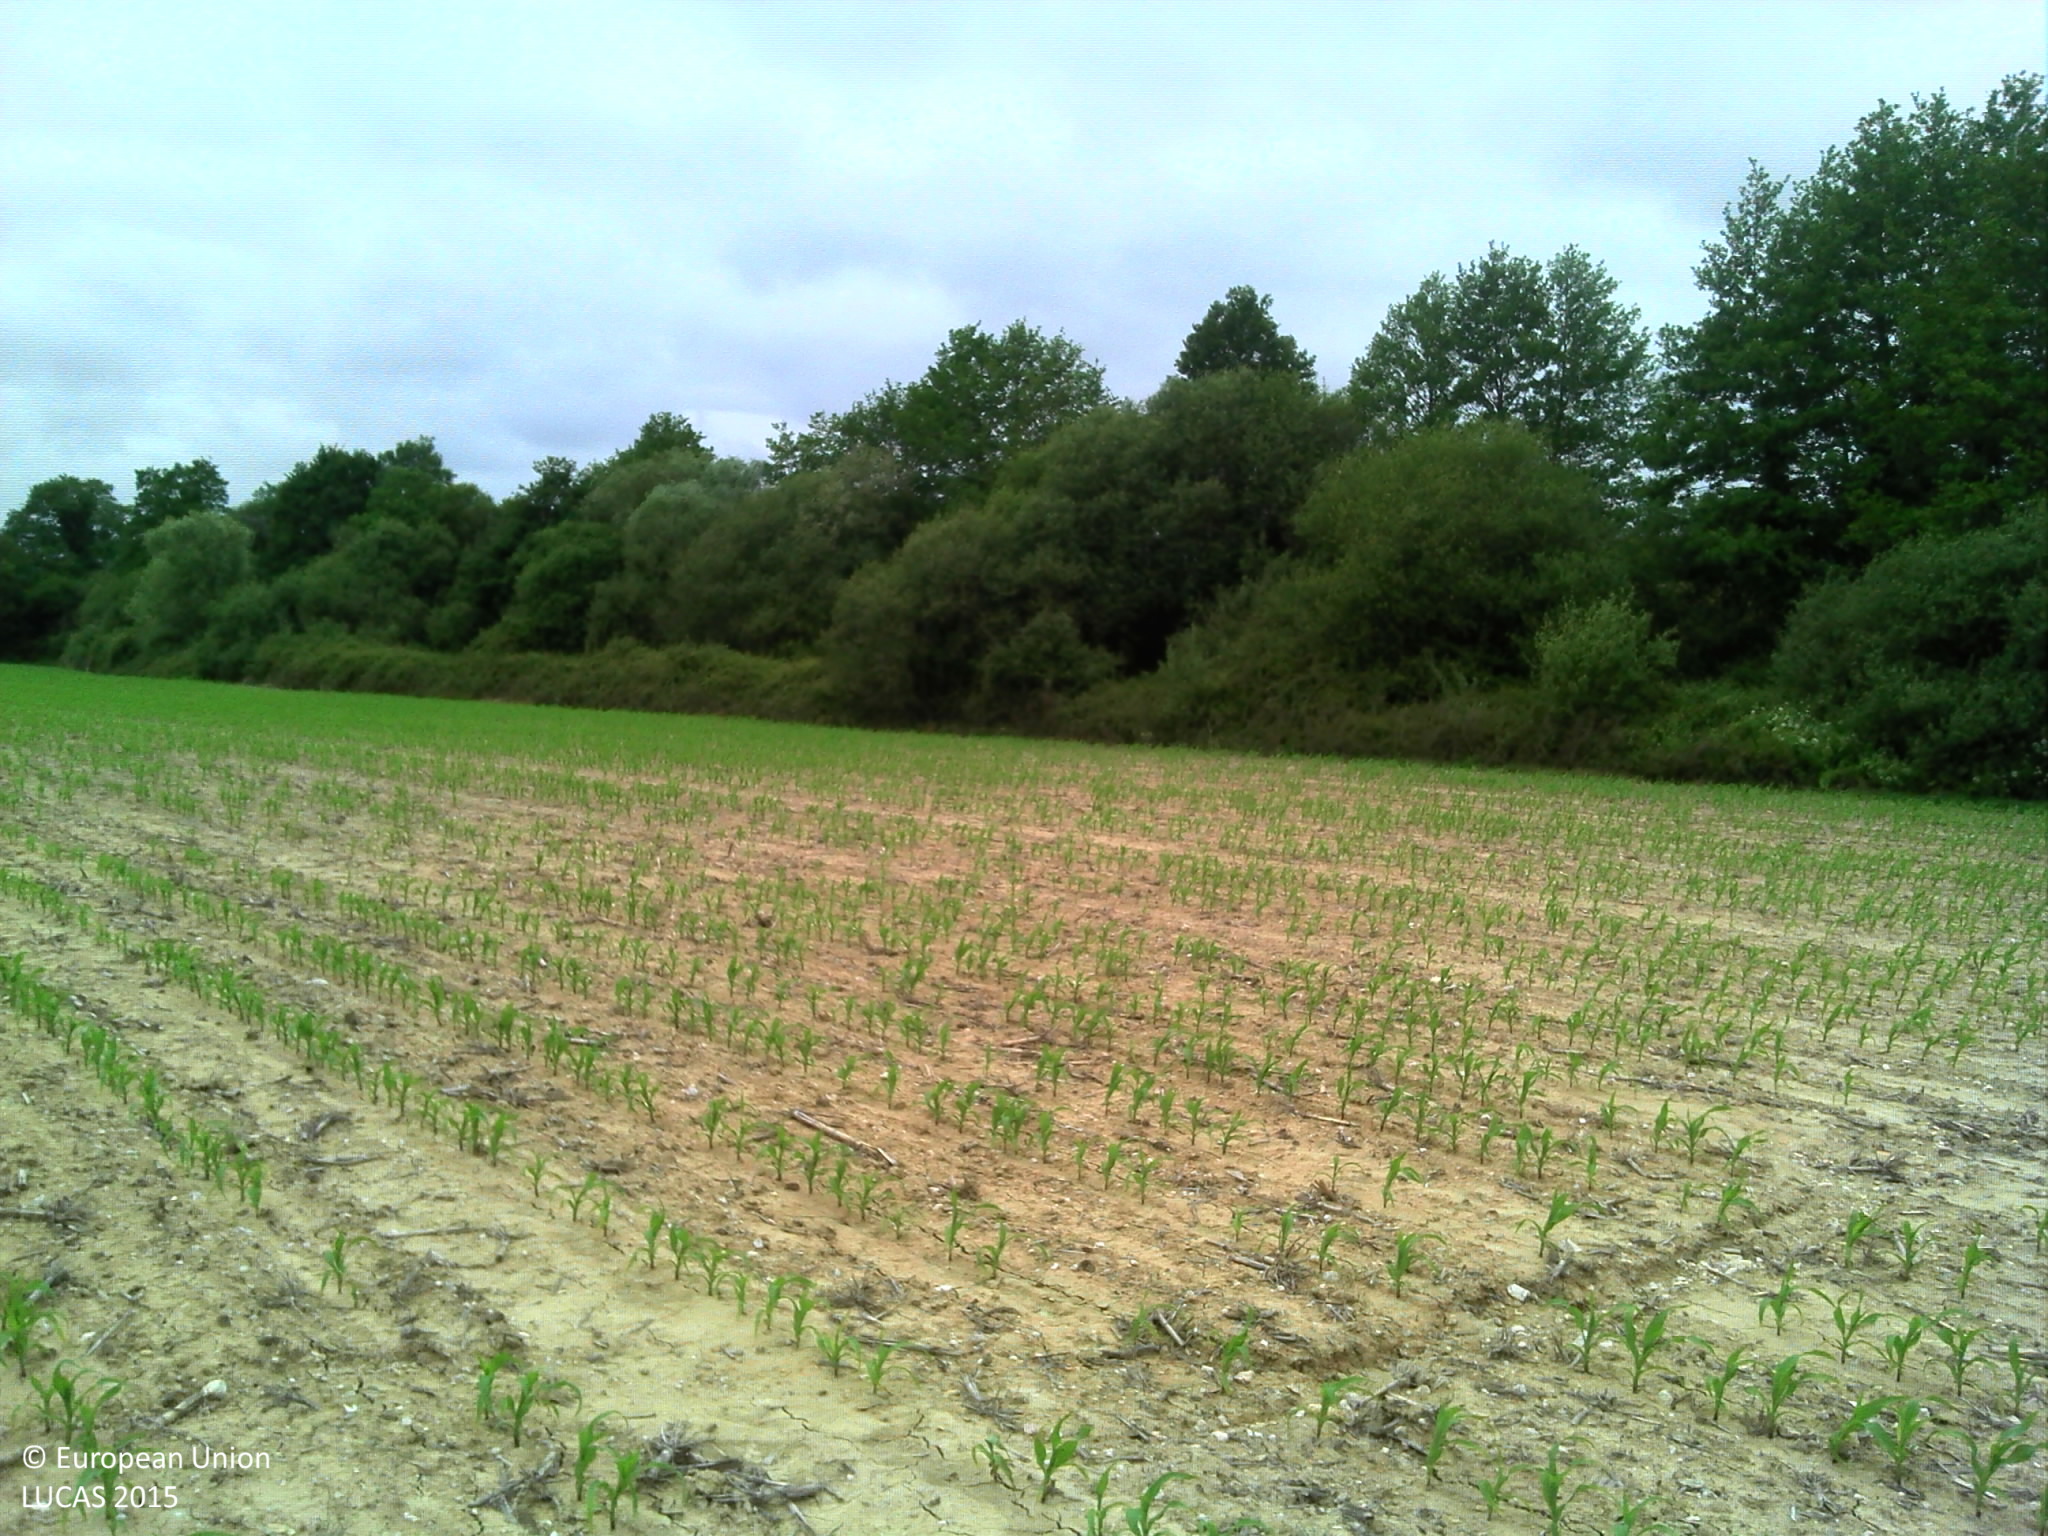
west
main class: Cropland
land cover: Maize
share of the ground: 10 - 25 %
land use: Agriculture (excluding fallow land and kitchen gardens)
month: June
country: FR
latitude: 46.8943
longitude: -1.8174
